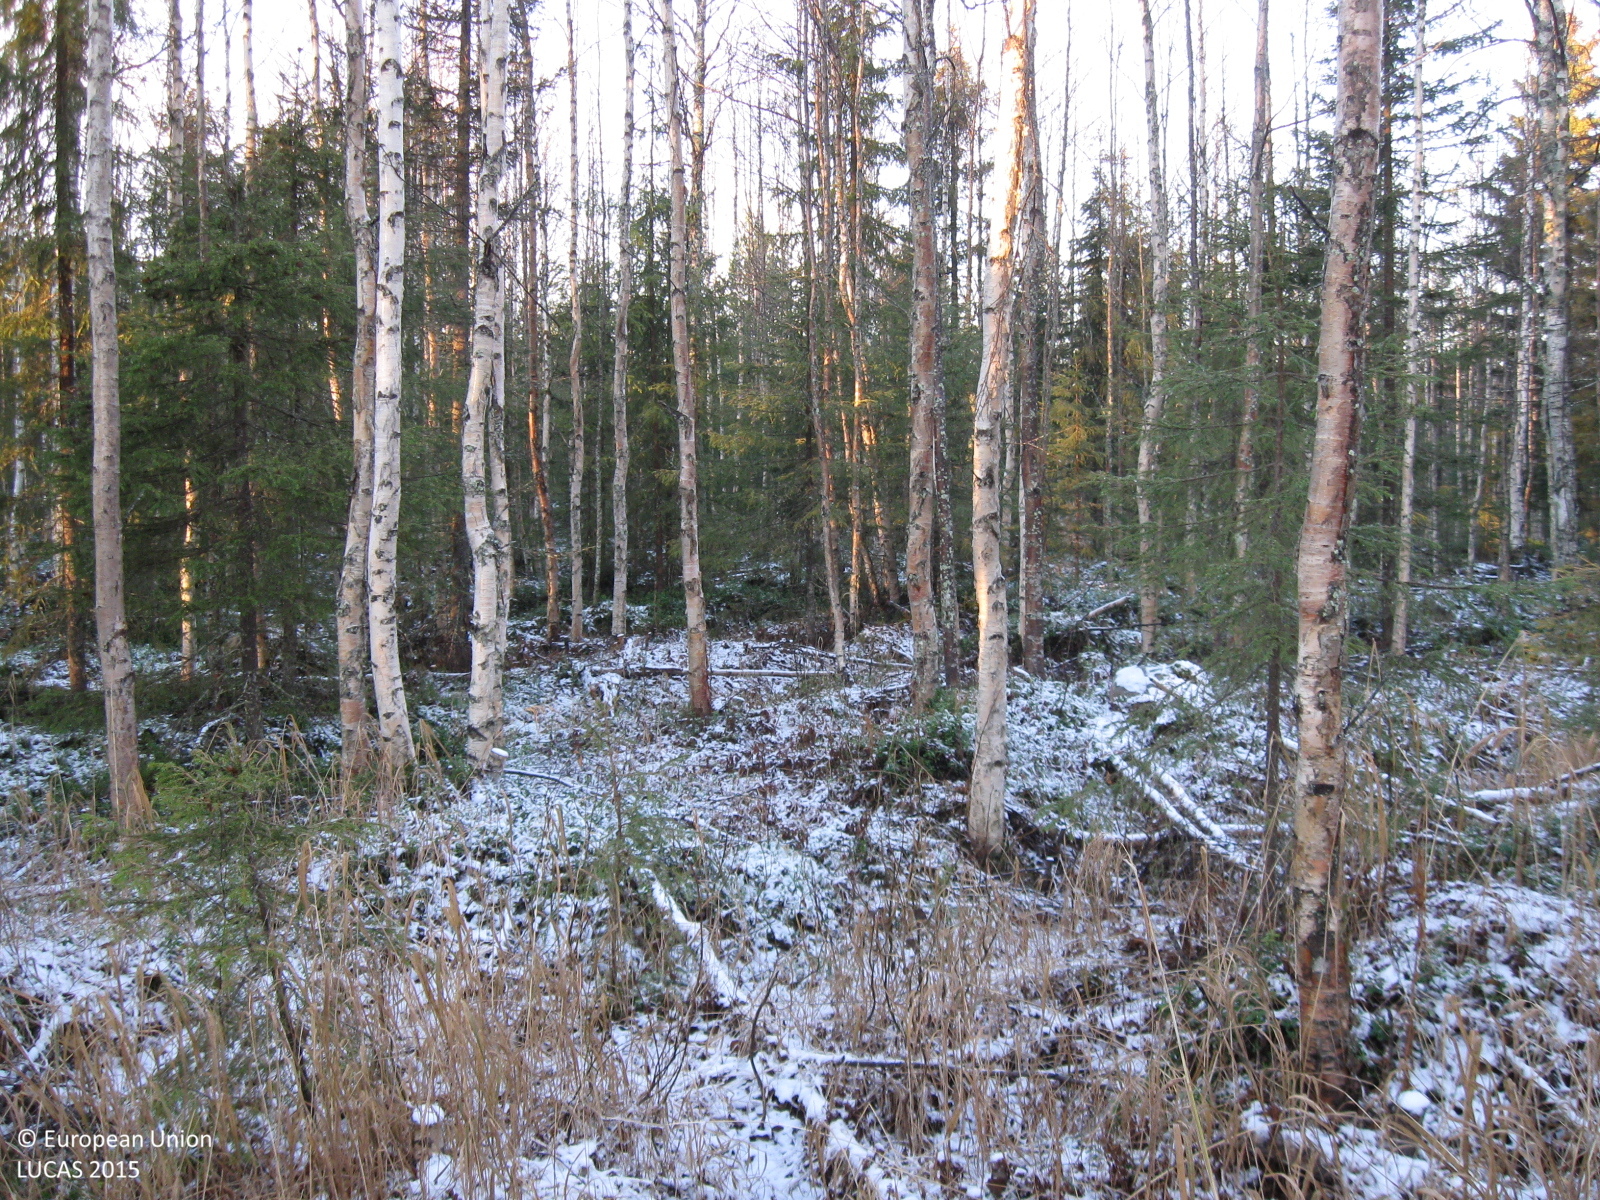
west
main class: Woodland
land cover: Spruce dominated mixed woodland
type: mire and swamp forests
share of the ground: > 75 %
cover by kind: broadleaved forest trees 55 %, coniferous forest trees 20 %, herbaceous plants 15 %, shrubs 10 %
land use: Forestry
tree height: > 5 m
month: October
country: SE
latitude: 66.3094
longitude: 20.8669
